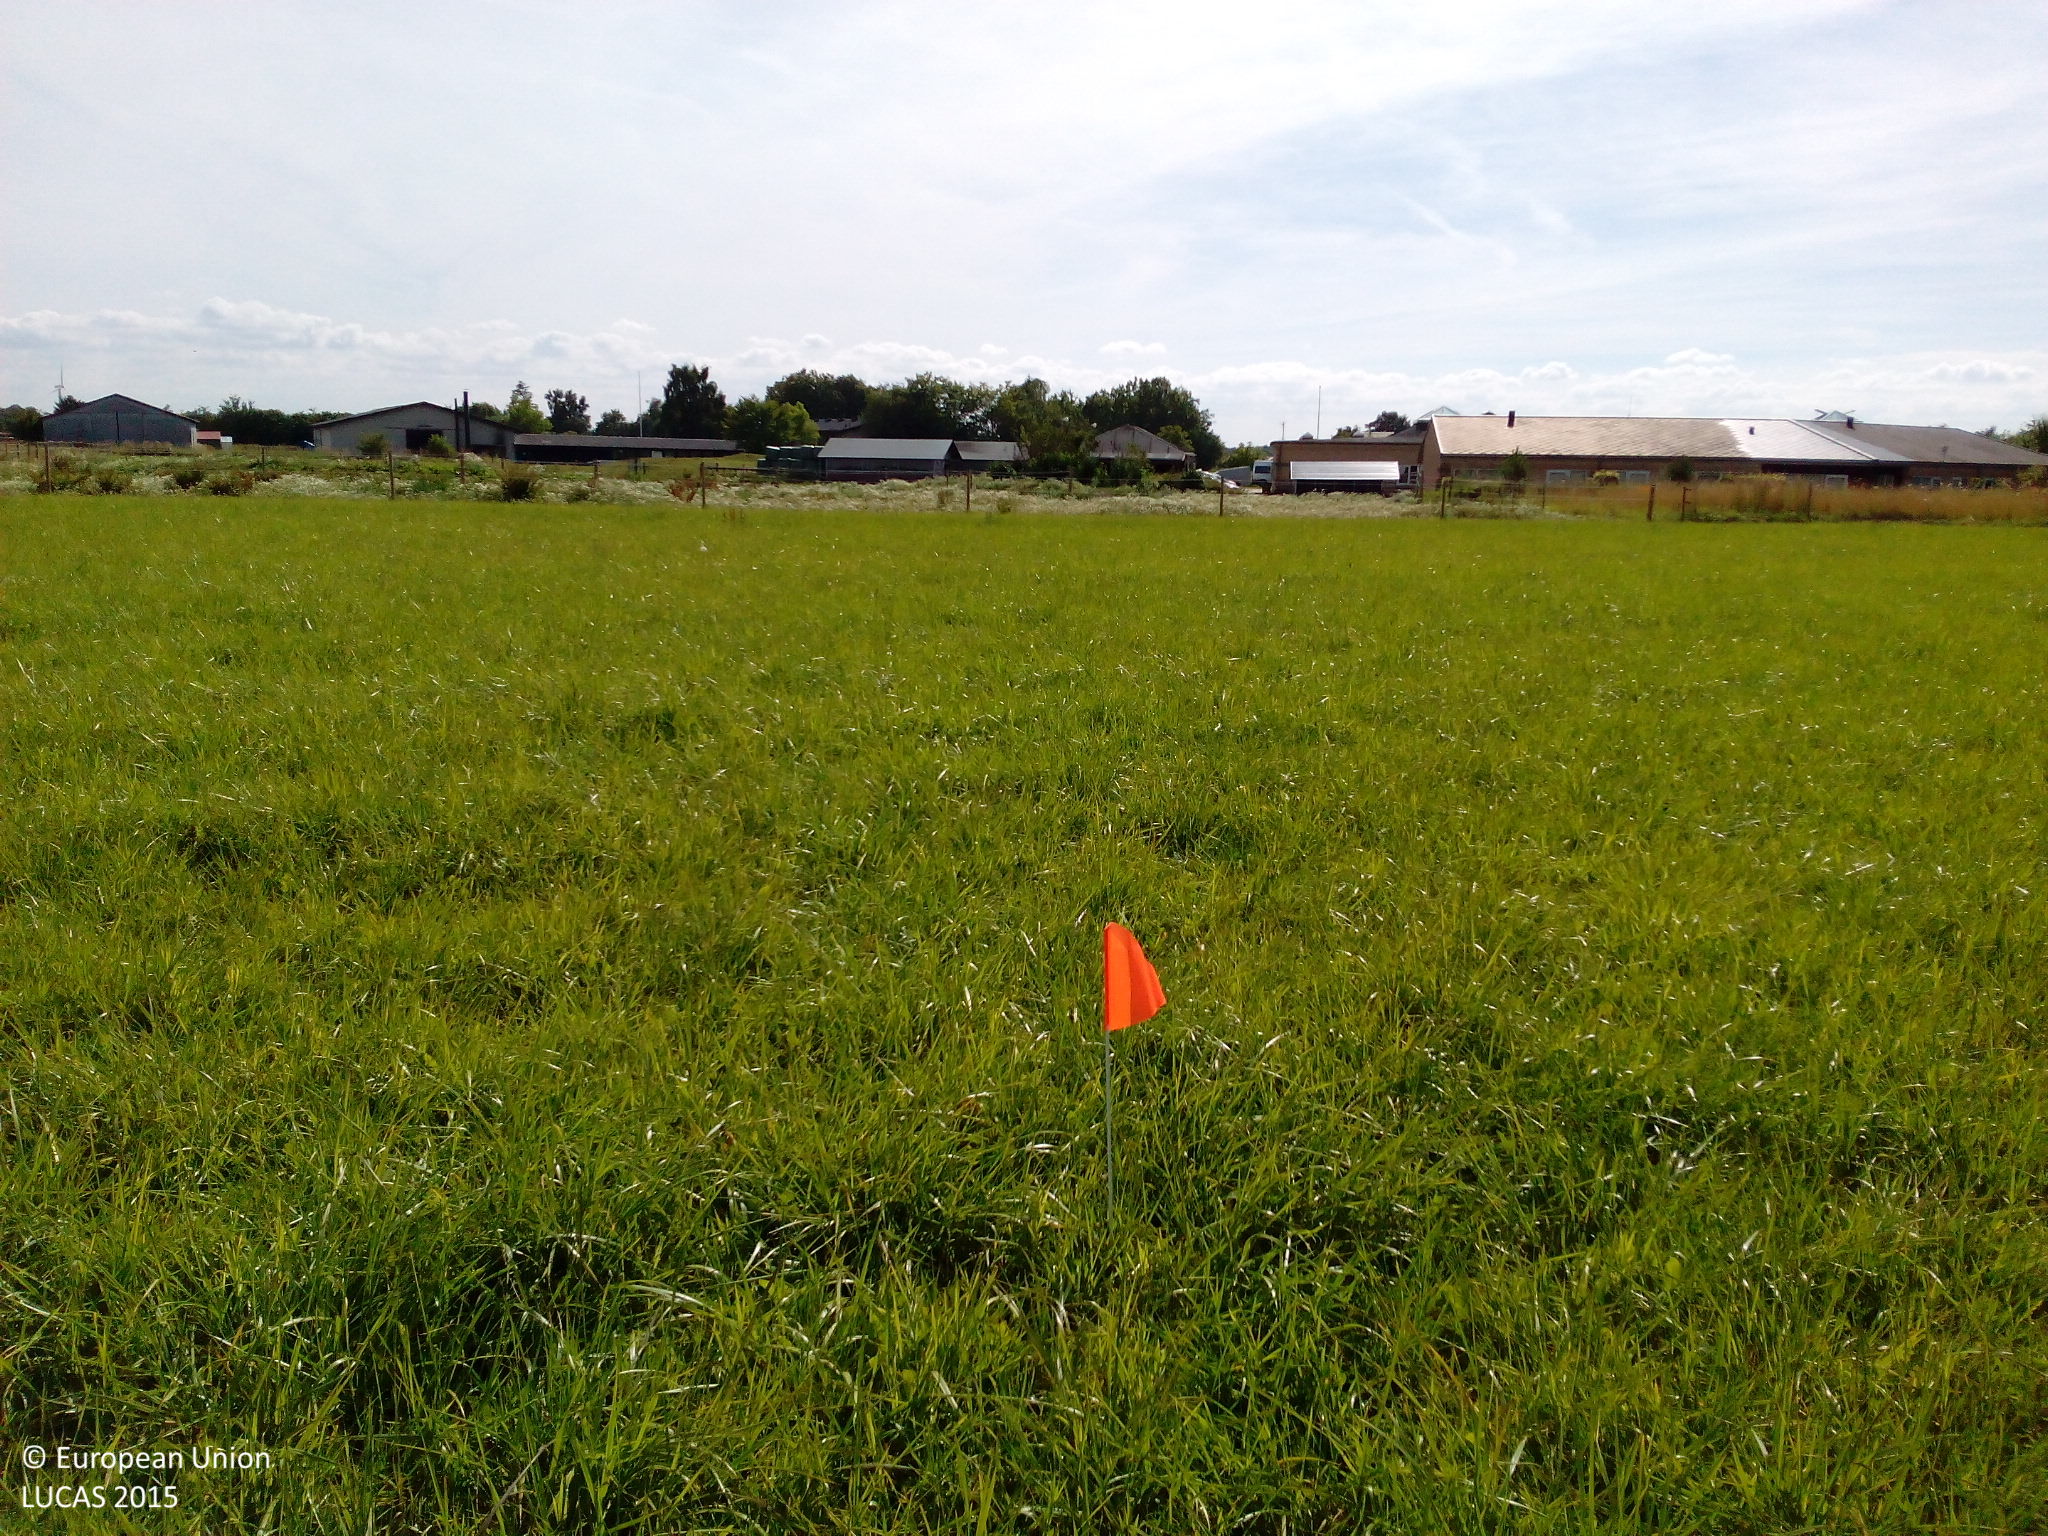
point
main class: Grassland
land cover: Grassland without tree/shrub cover
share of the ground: > 75 %
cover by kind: herbaceous plants 100 %
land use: Agriculture (excluding fallow land and kitchen gardens)
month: August
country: DK
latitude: 55.6140
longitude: 12.0464
